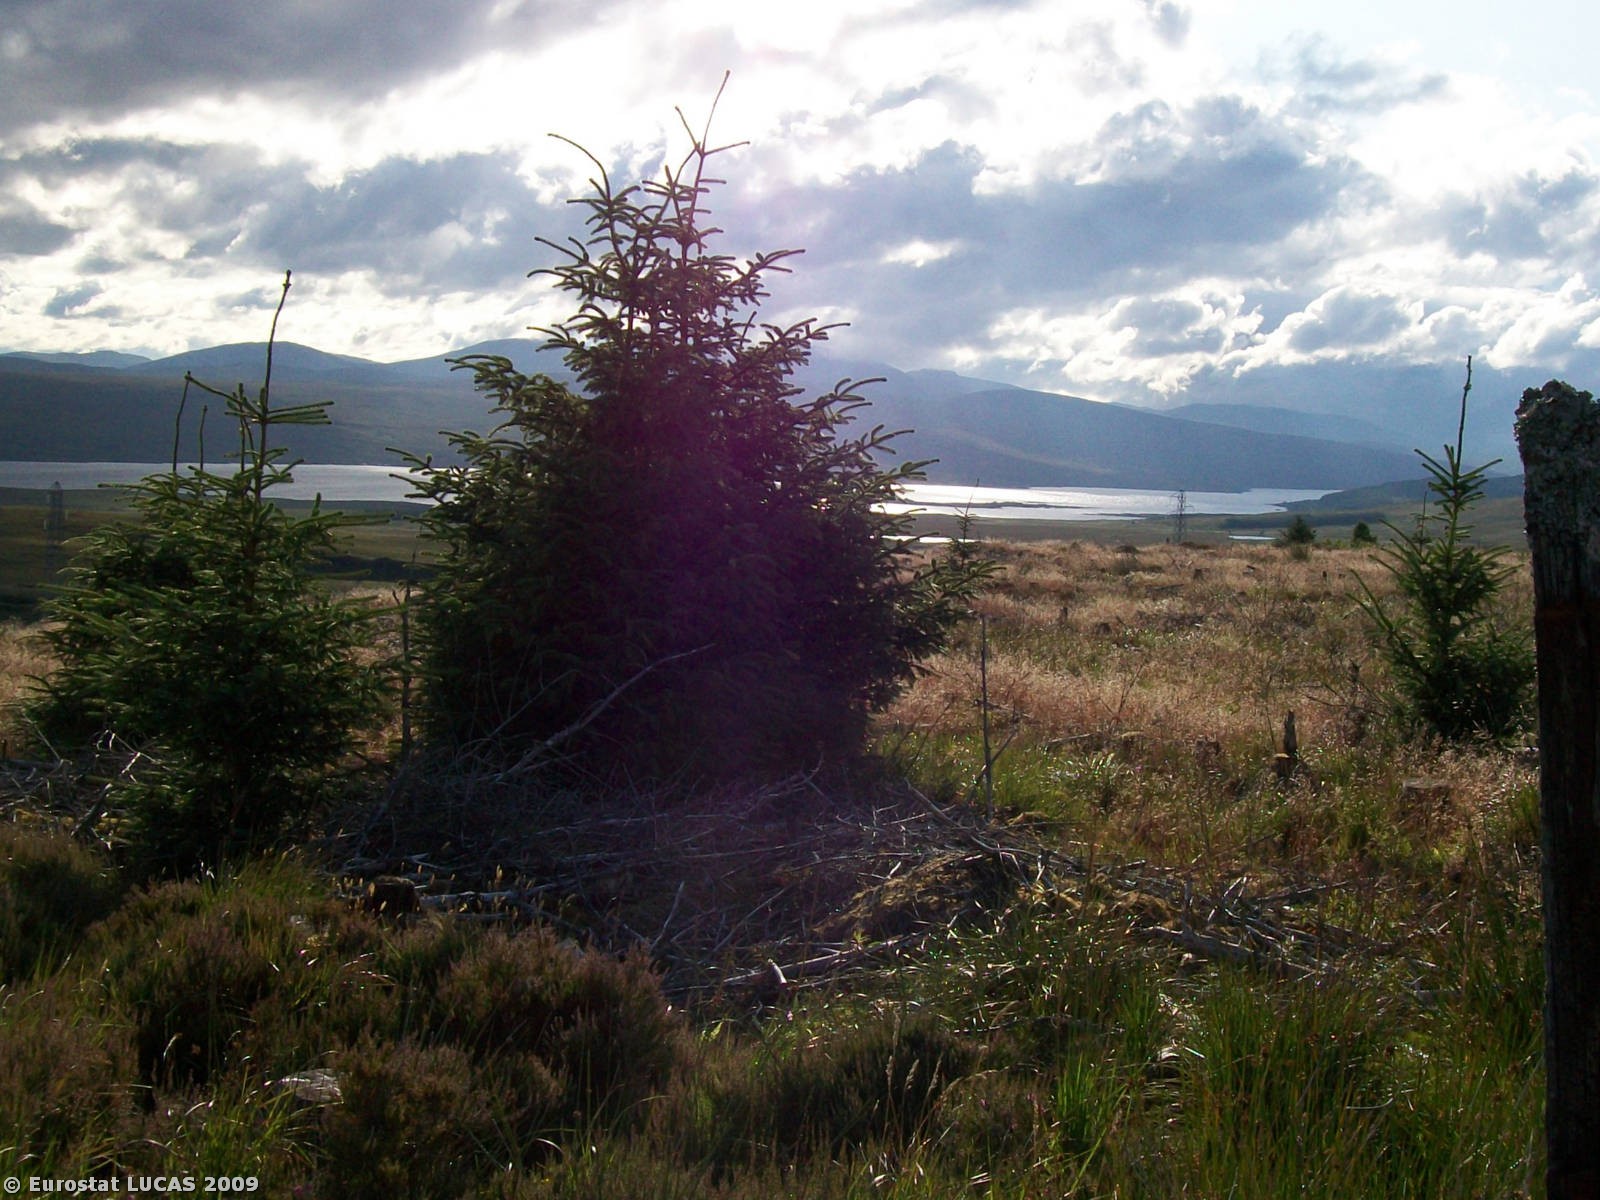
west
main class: Shrubland
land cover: Shrubland without tree cover
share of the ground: > 75 %
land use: Agriculture (excluding fallow land and kitchen gardens)
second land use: Forestry
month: August
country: GB
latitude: 58.1372
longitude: -4.5419
